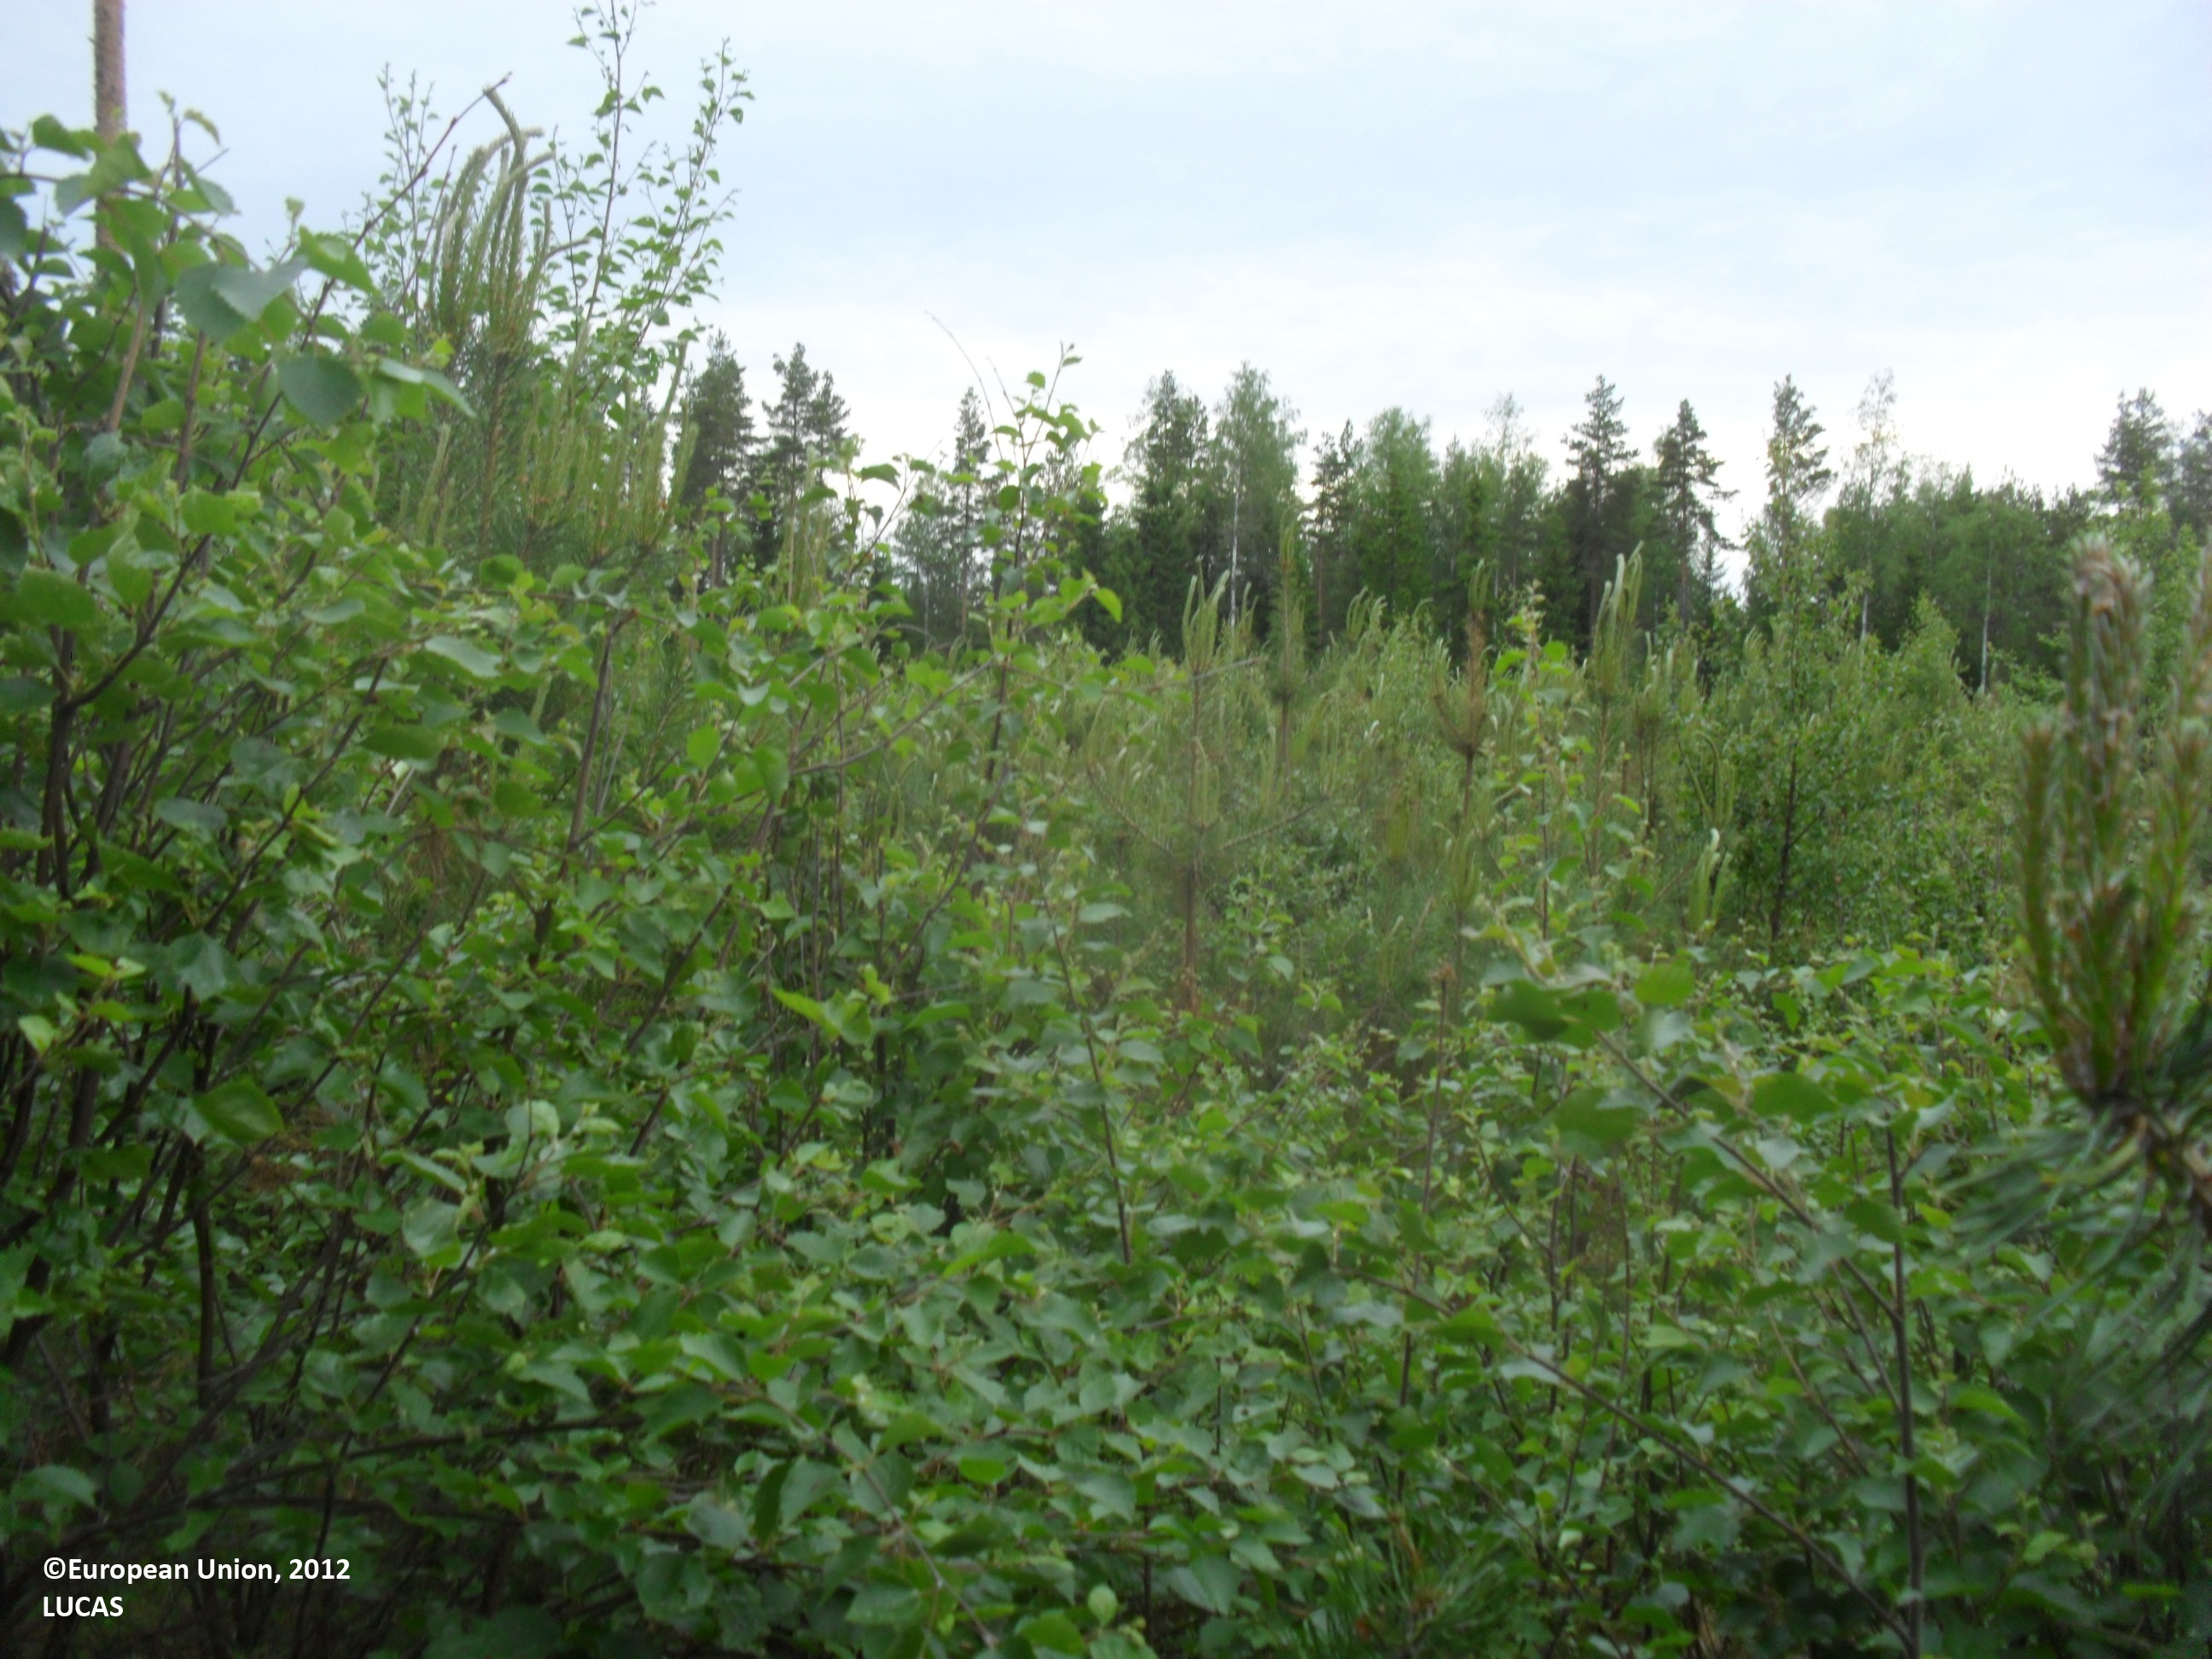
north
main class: Woodland
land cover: Other mixed woodland
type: boreal forest
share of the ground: 50 - 75 %
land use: Forestry
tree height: < 5 m
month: June
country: FI
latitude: 63.4854
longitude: 22.8822
